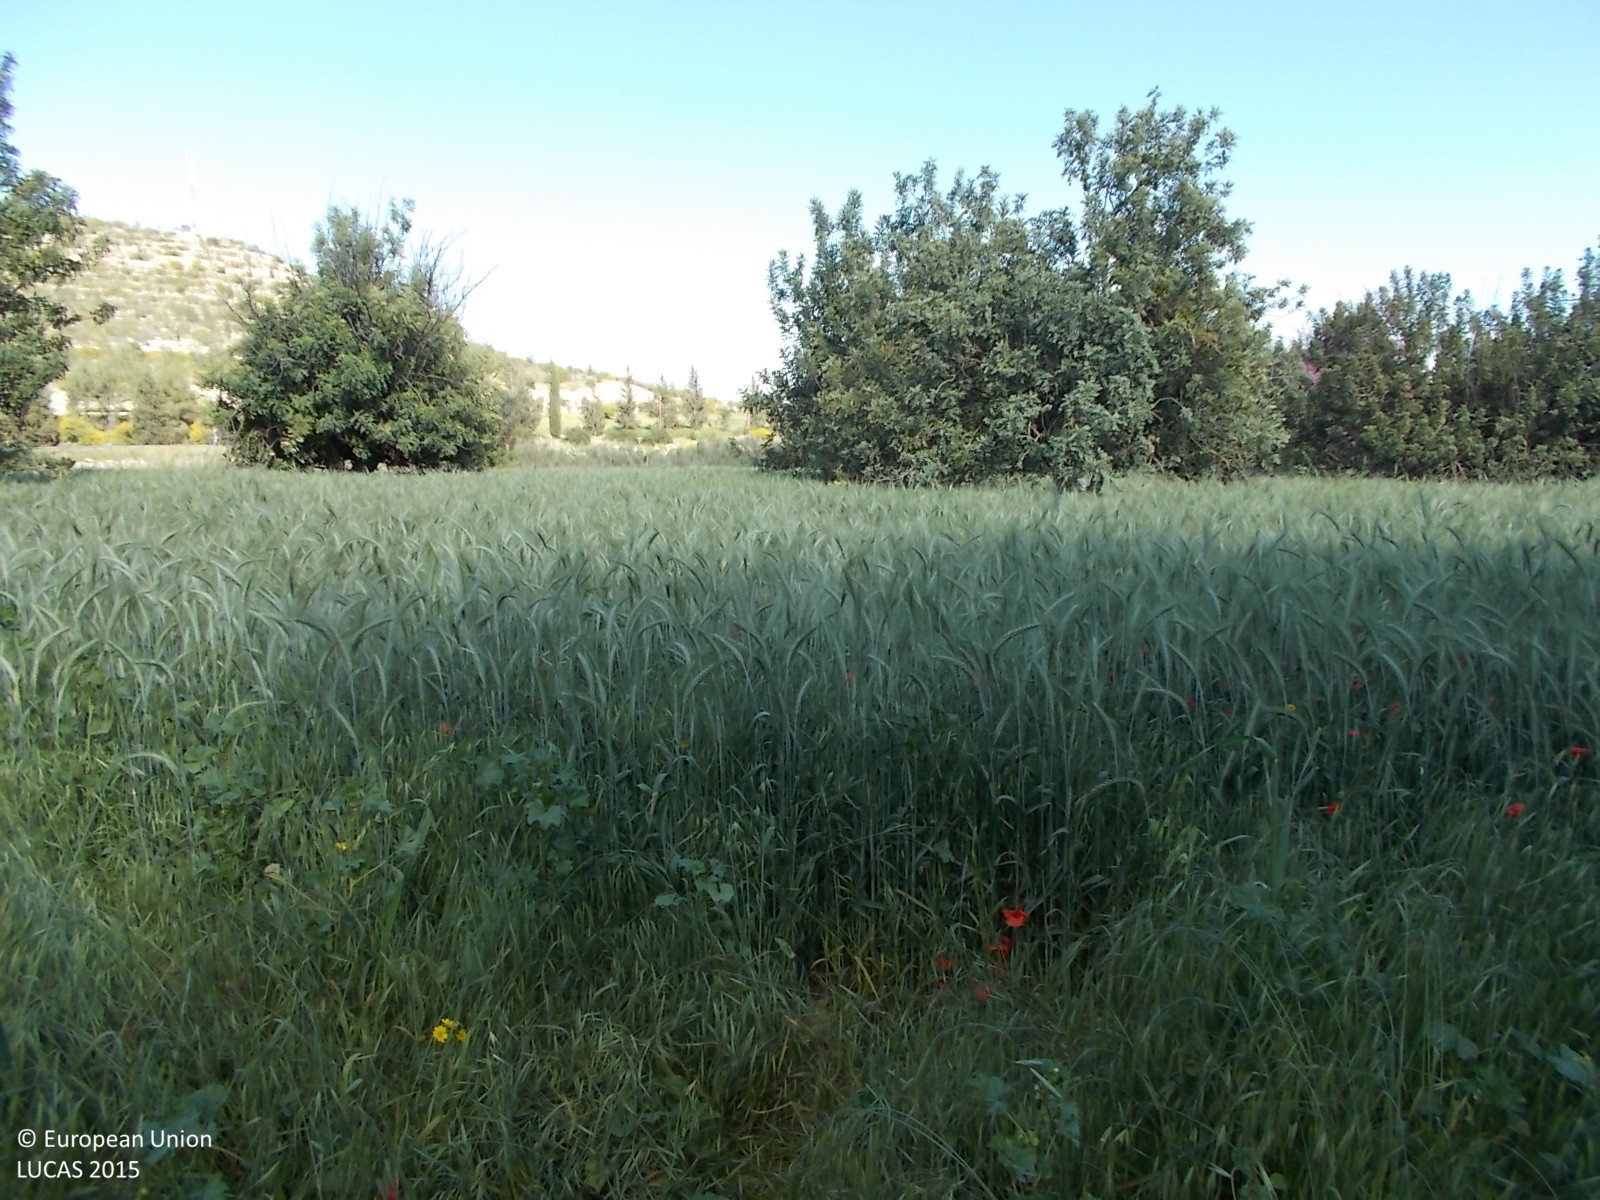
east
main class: Cropland
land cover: Other fruit trees and berries
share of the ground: 50 - 75 %
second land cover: Spontaneously vegetated surfaces
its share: > 75 %
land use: Agriculture (excluding fallow land and kitchen gardens)
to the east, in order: Other fruit trees and berries; Spontaneously vegetated surfaces; Common wheat; Other fruit trees and berries; Grass margins; Permanent industrial crops; Rivers and streams; Permanent industrial crops; Spontaneously vegetated surfaces; Mixed cereals for fodder; Electric lines; Mixed cereals for fodder; Grassland with sparse tree/shrub cover; Paved roads, cycling and walking lanes
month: April
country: CY
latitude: 34.9798
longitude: 33.5151
